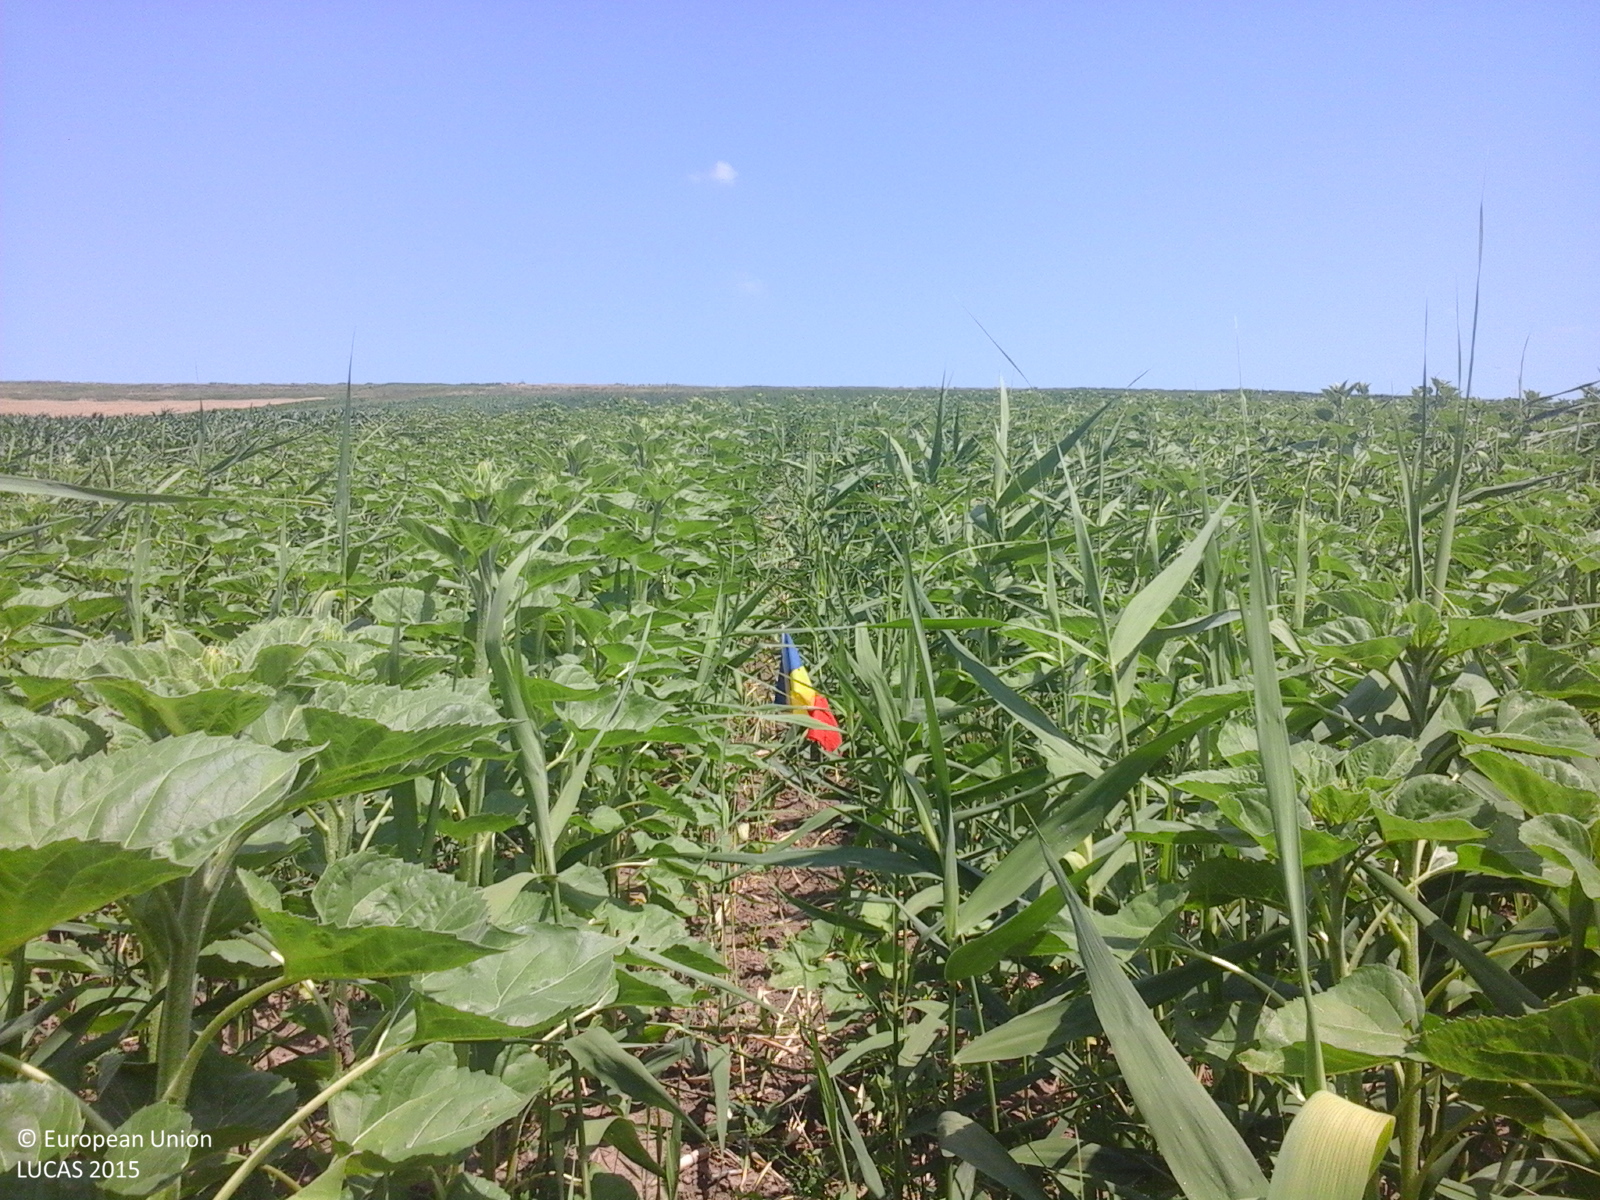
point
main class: Cropland
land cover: Sunflower
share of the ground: > 75 %
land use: Agriculture (excluding fallow land and kitchen gardens)
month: June
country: RO
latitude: 47.2516
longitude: 27.3824
